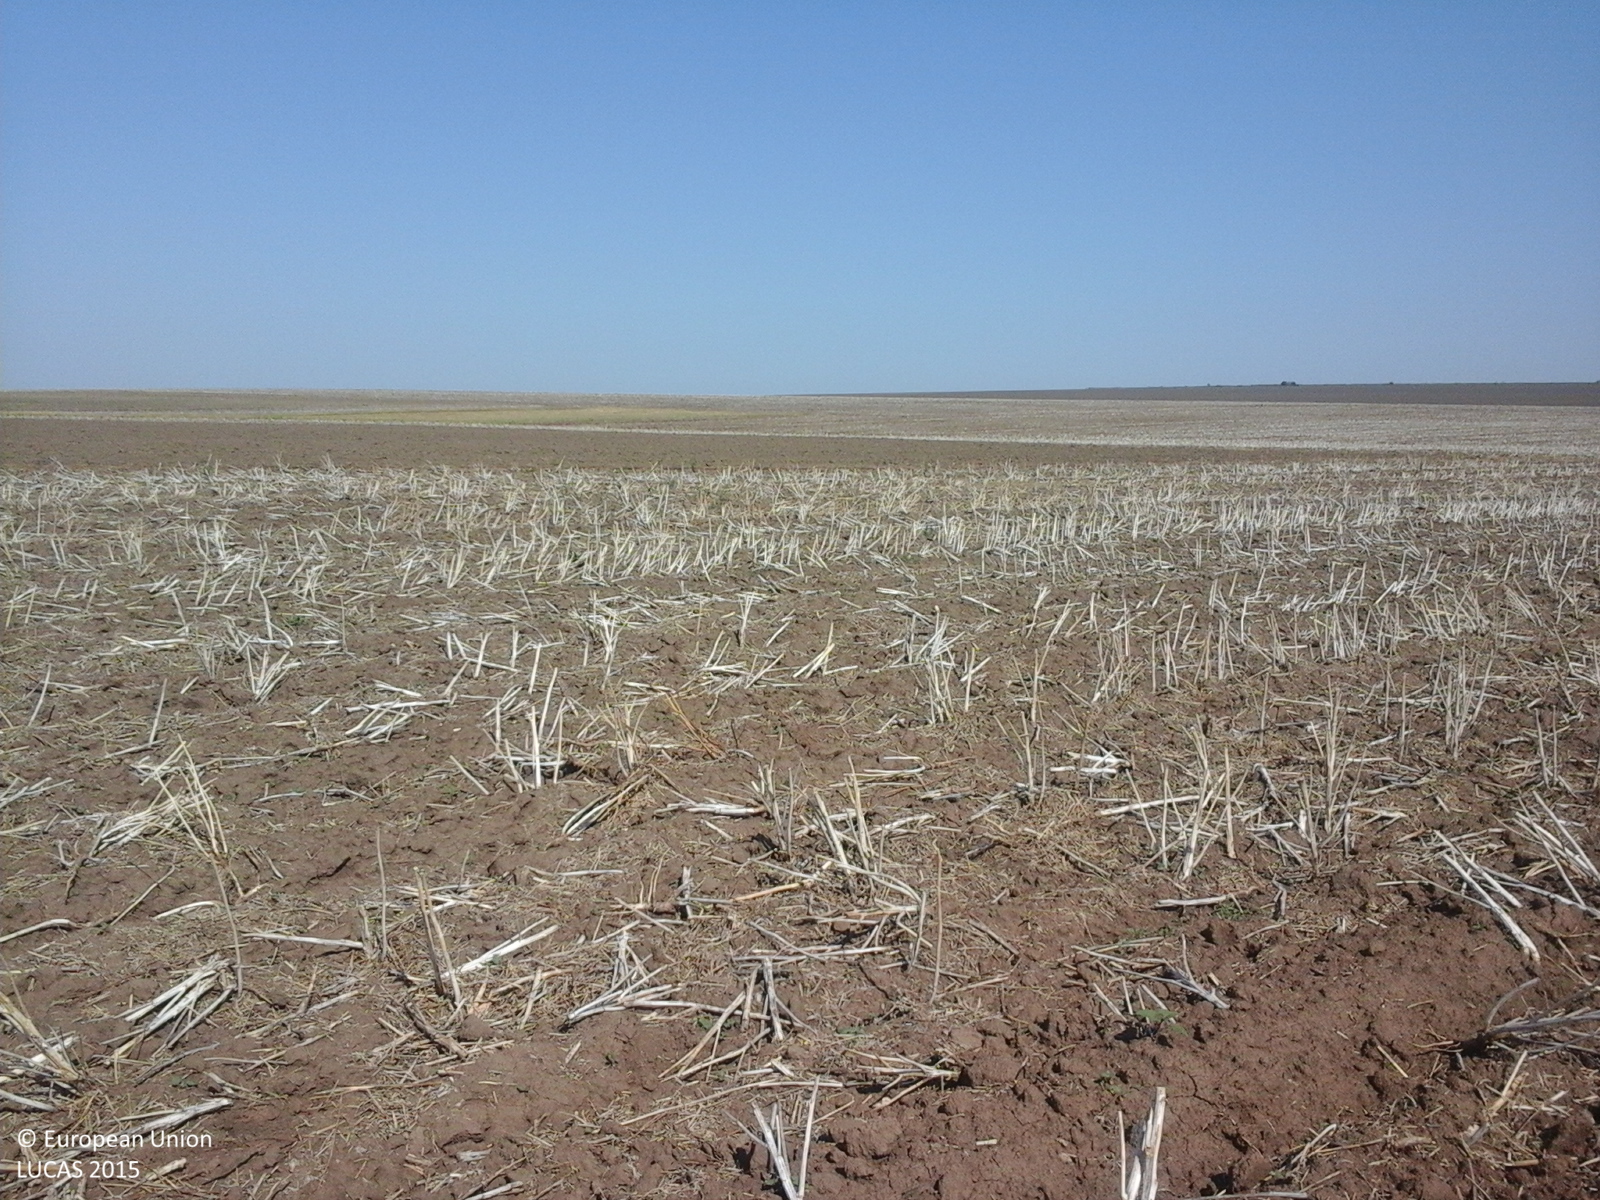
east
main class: Cropland
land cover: Rape and turnip rape
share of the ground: 10 - 25 %
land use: Agriculture (excluding fallow land and kitchen gardens)
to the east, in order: Rape and turnip rape
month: August
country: RO
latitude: 44.2540
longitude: 28.4161
